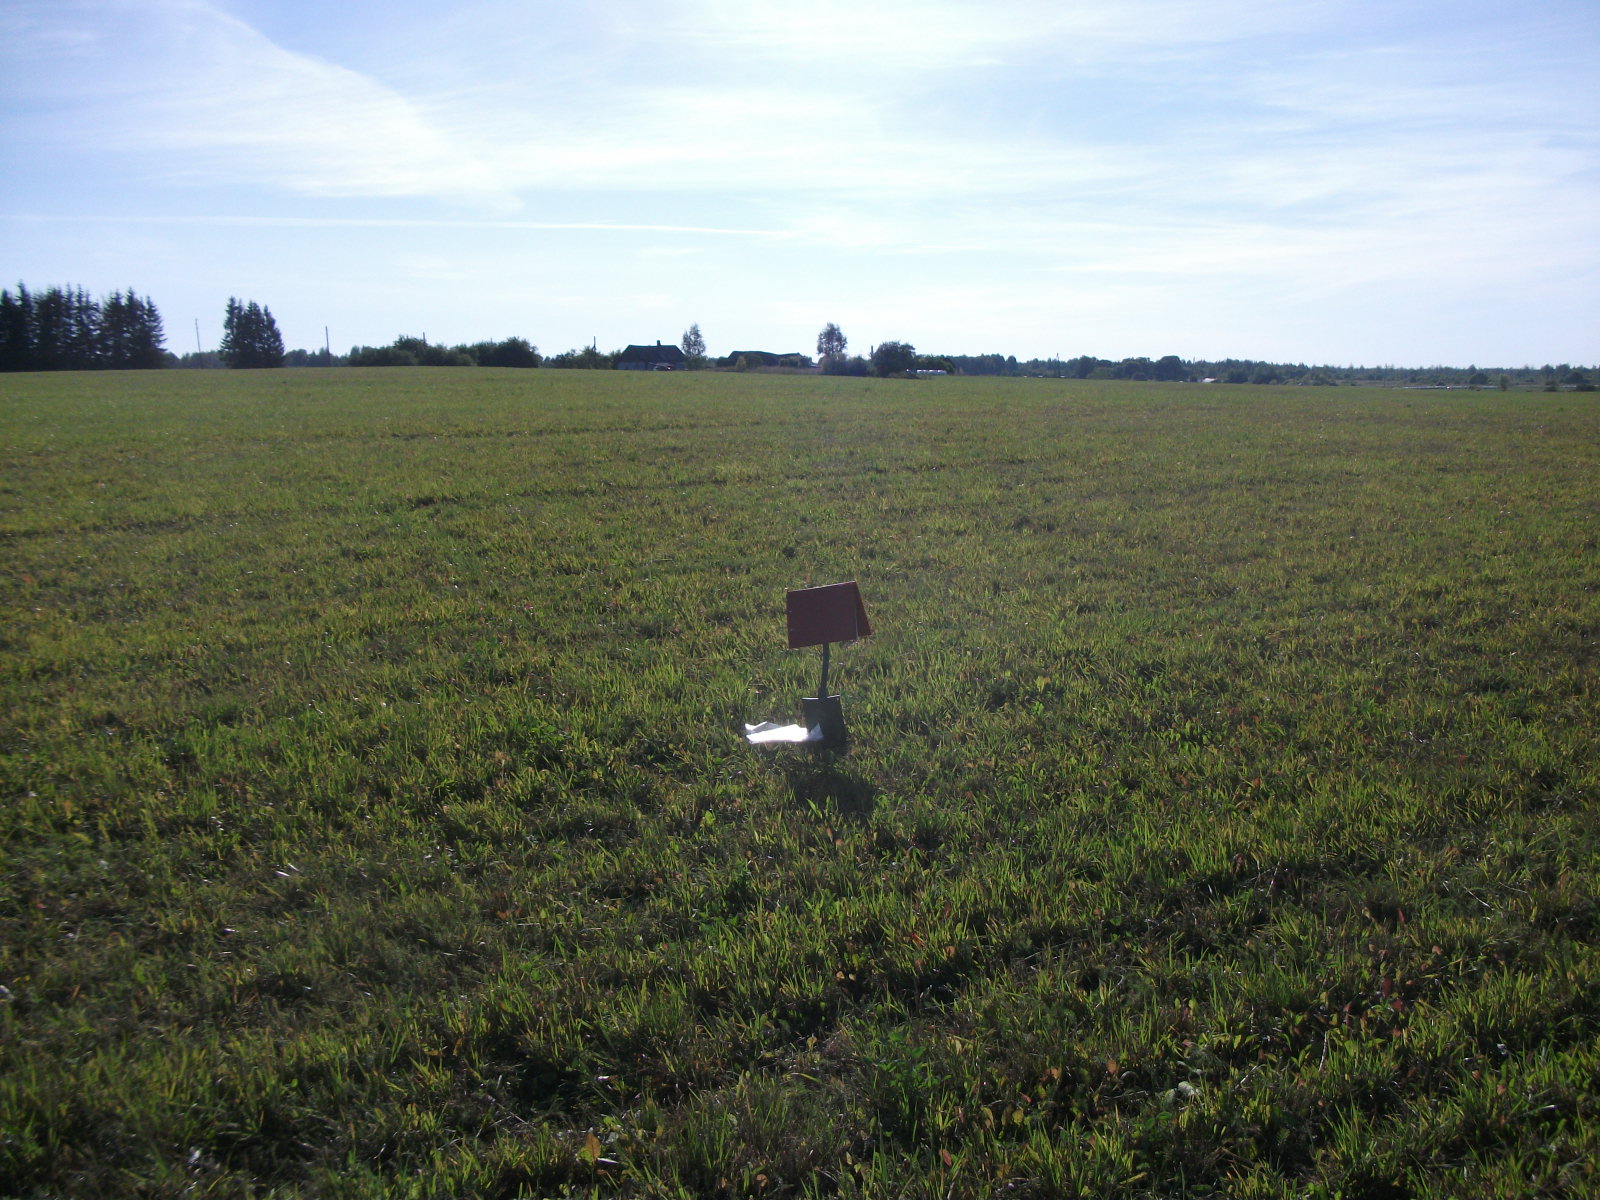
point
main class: Grassland
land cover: Grassland without tree/shrub cover
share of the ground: > 75 %
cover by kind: herbaceous plants 100 %
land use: Agriculture (excluding fallow land and kitchen gardens)
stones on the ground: < 10 %
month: August
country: LV
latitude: 56.3559
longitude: 26.2442
